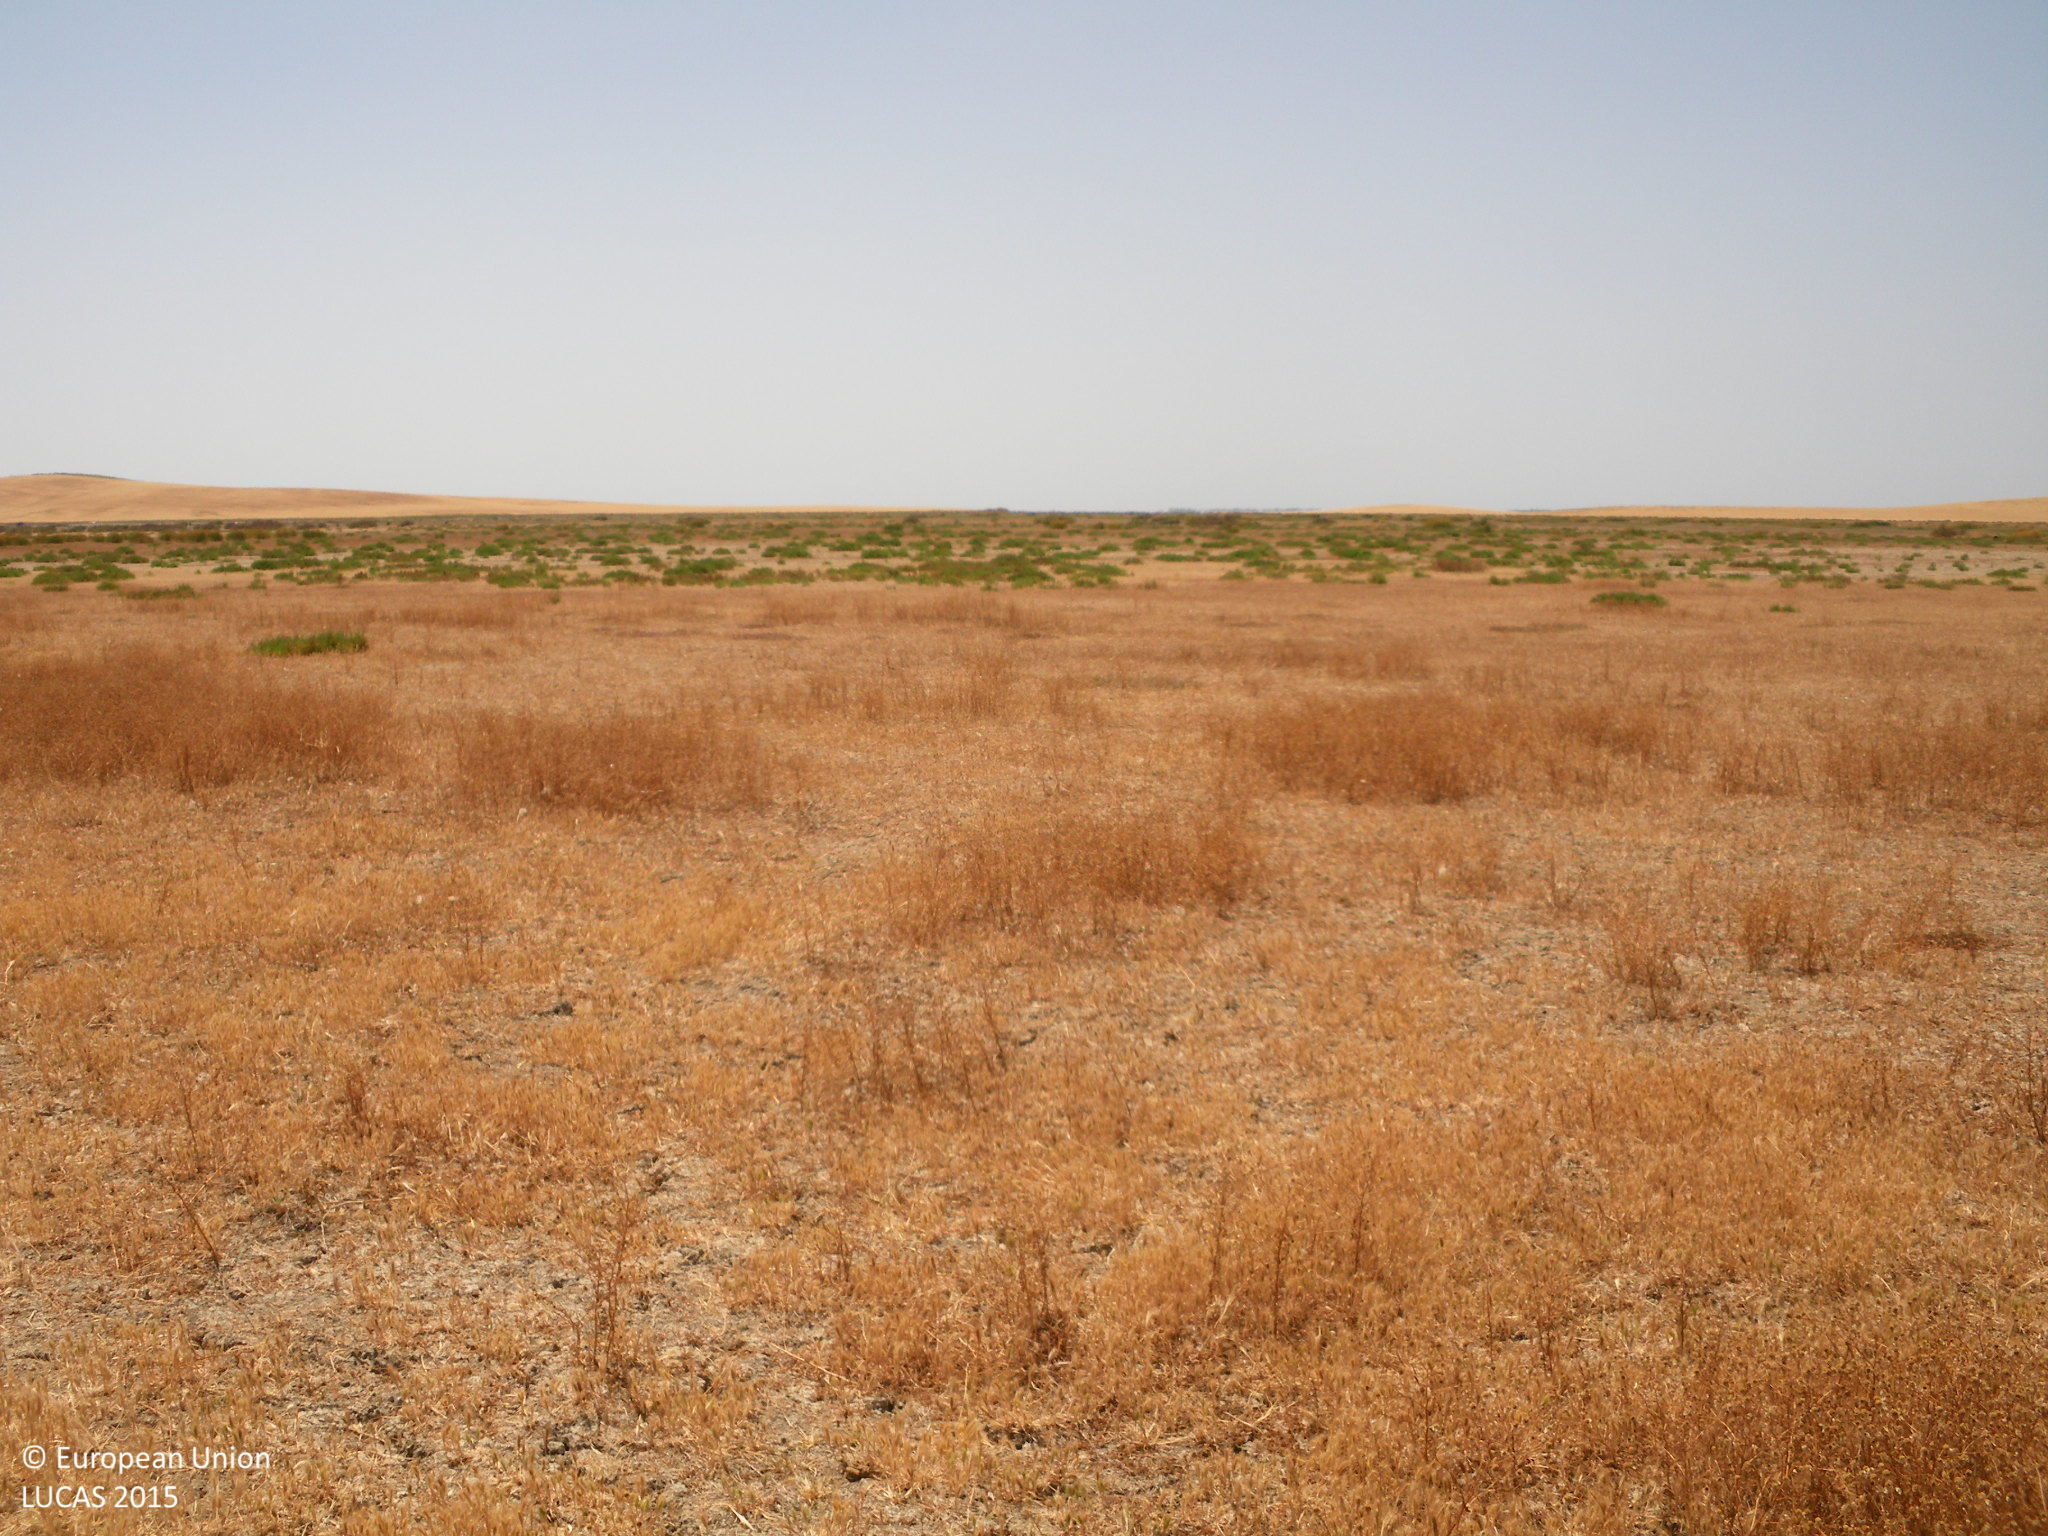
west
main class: Grassland
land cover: Spontaneously vegetated surfaces
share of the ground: > 75 %
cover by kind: herbaceous plants 90 %, unconsolidated bare surface 10 %
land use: Agriculture (excluding fallow land and kitchen gardens)
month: May
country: ES
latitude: 36.8430
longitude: -6.2210
